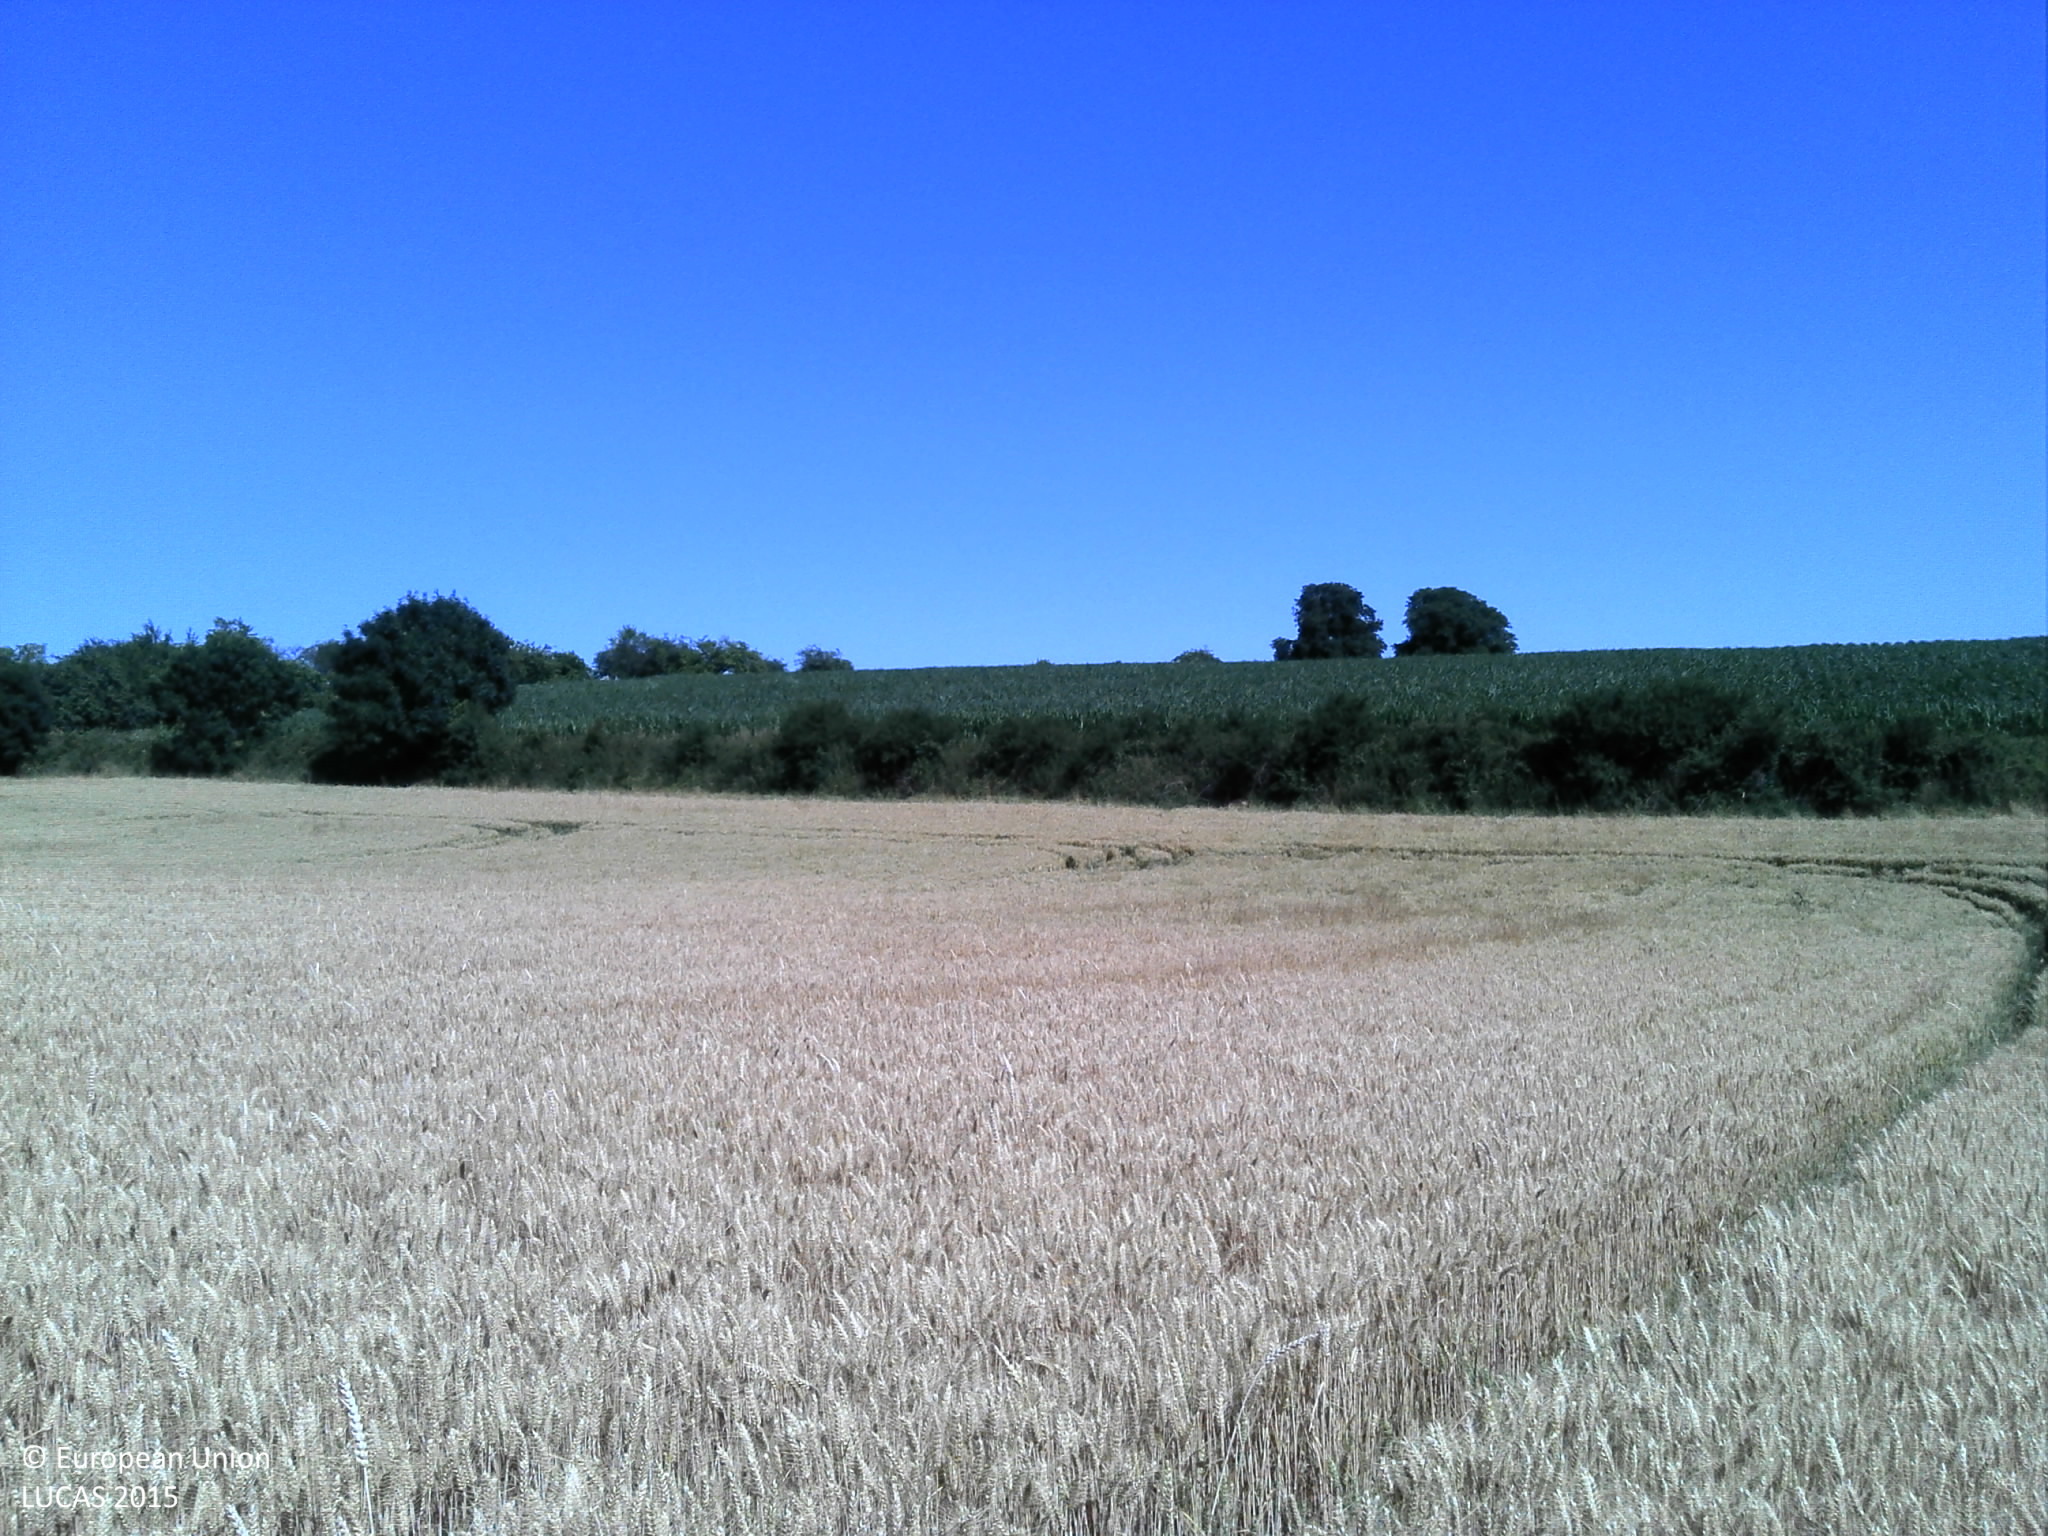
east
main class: Cropland
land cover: Common wheat
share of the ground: > 75 %
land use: Agriculture (excluding fallow land and kitchen gardens)
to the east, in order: Common wheat; Abandoned hedges; Maize; Apple fruit; Grassland without tree/shrub cover
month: July
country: FR
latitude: 49.5232
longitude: 4.7612
